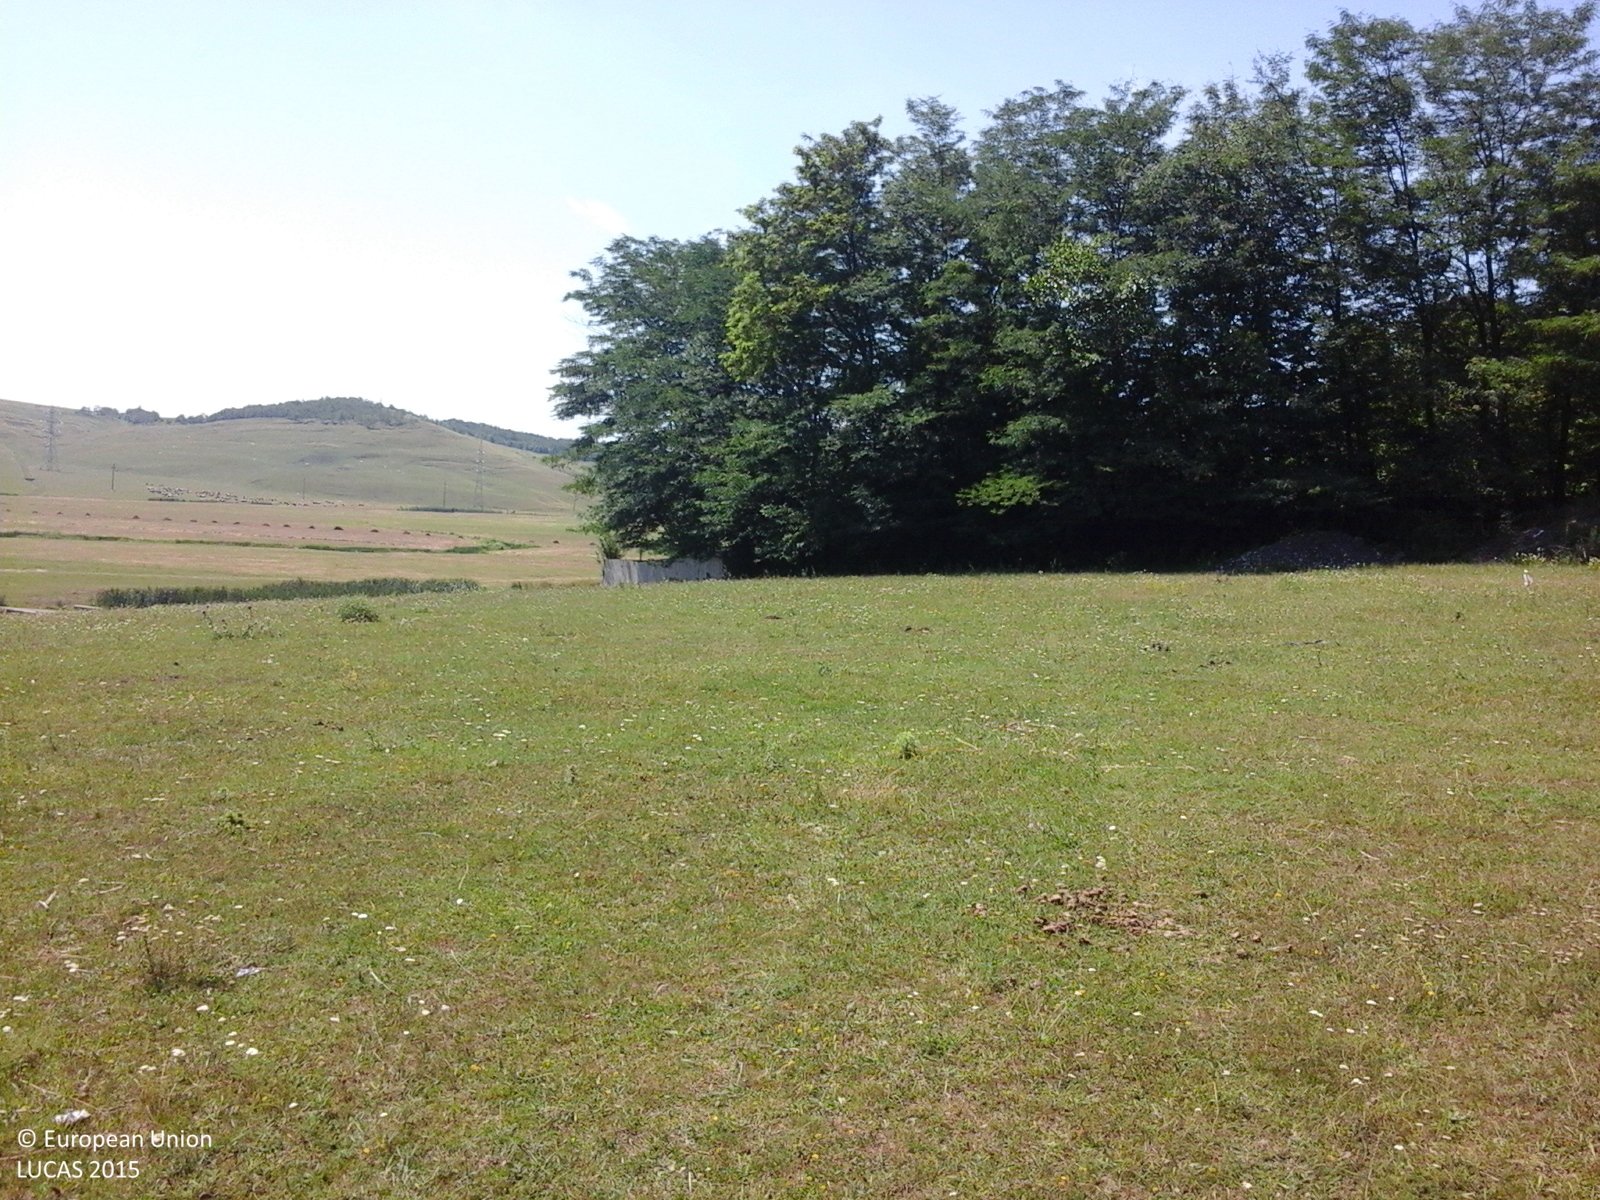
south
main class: Grassland
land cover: Grassland without tree/shrub cover
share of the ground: > 75 %
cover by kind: herbaceous plants 100 %
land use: Agriculture (excluding fallow land and kitchen gardens)
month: June
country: RO
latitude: 47.2152
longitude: 27.1522
